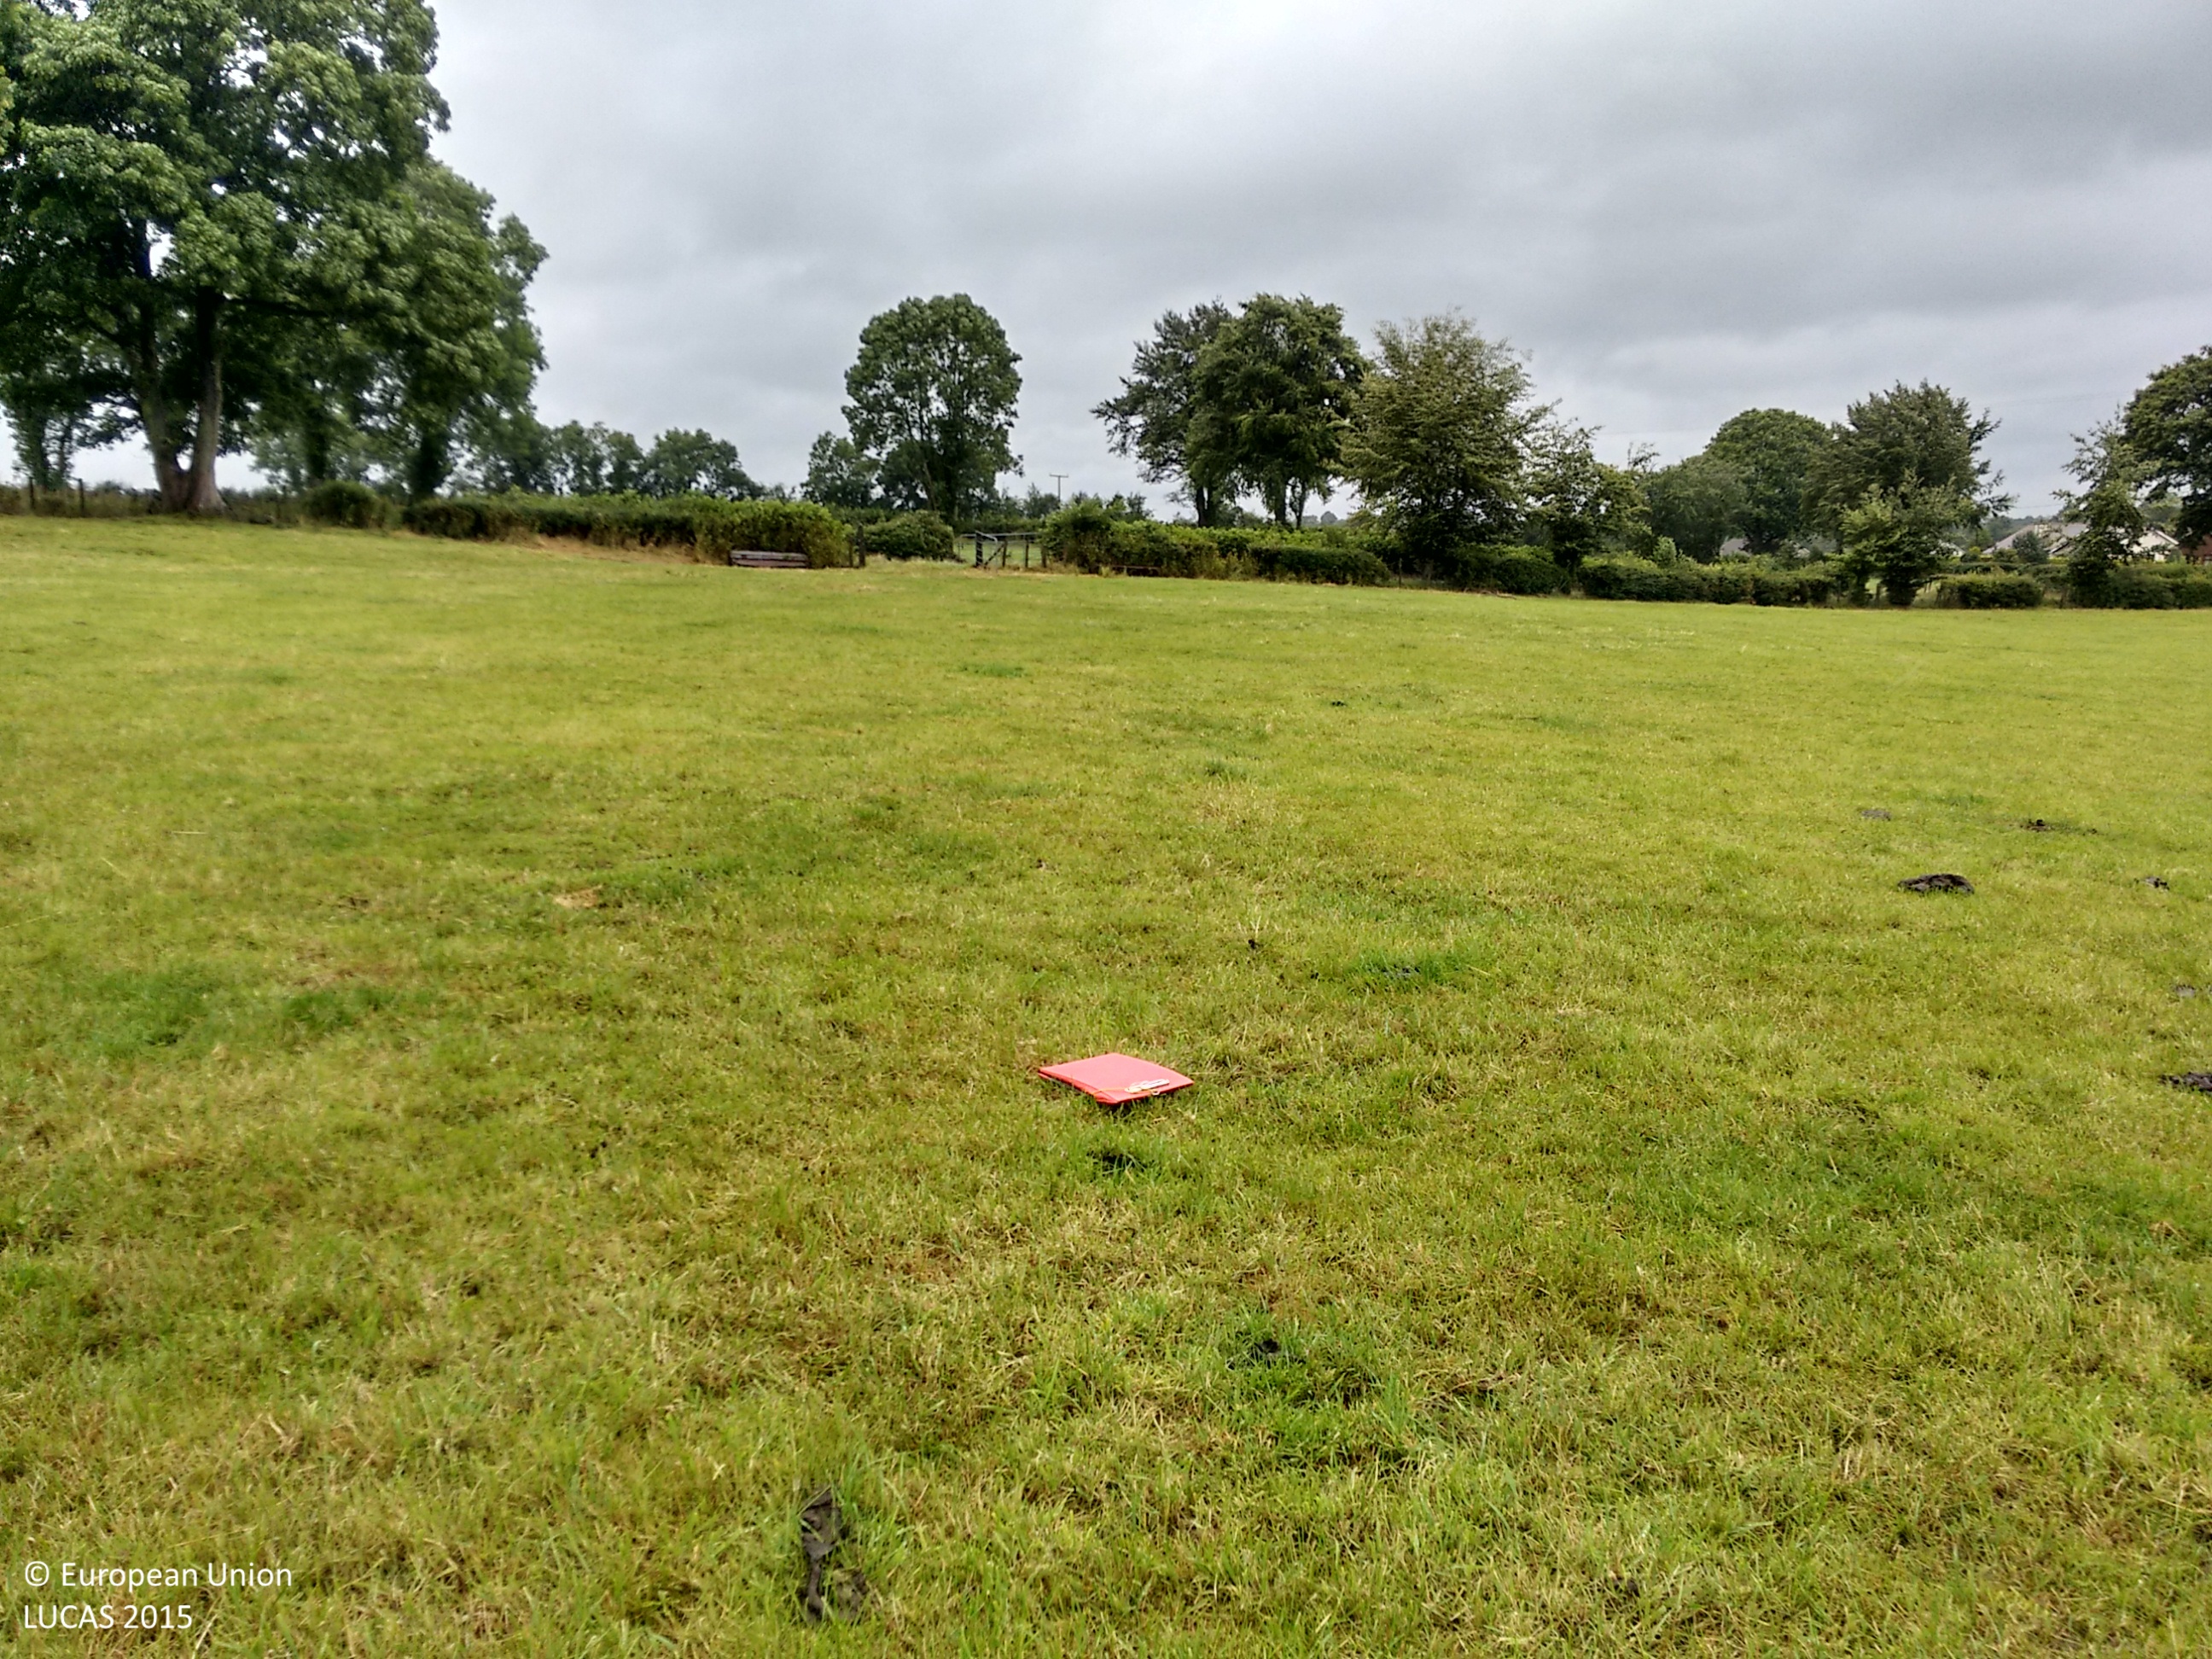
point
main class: Grassland
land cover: Grassland without tree/shrub cover
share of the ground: > 75 %
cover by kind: herbaceous plants 100 %
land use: Agriculture (excluding fallow land and kitchen gardens)
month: August
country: GB
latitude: 54.6785
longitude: -6.5493
